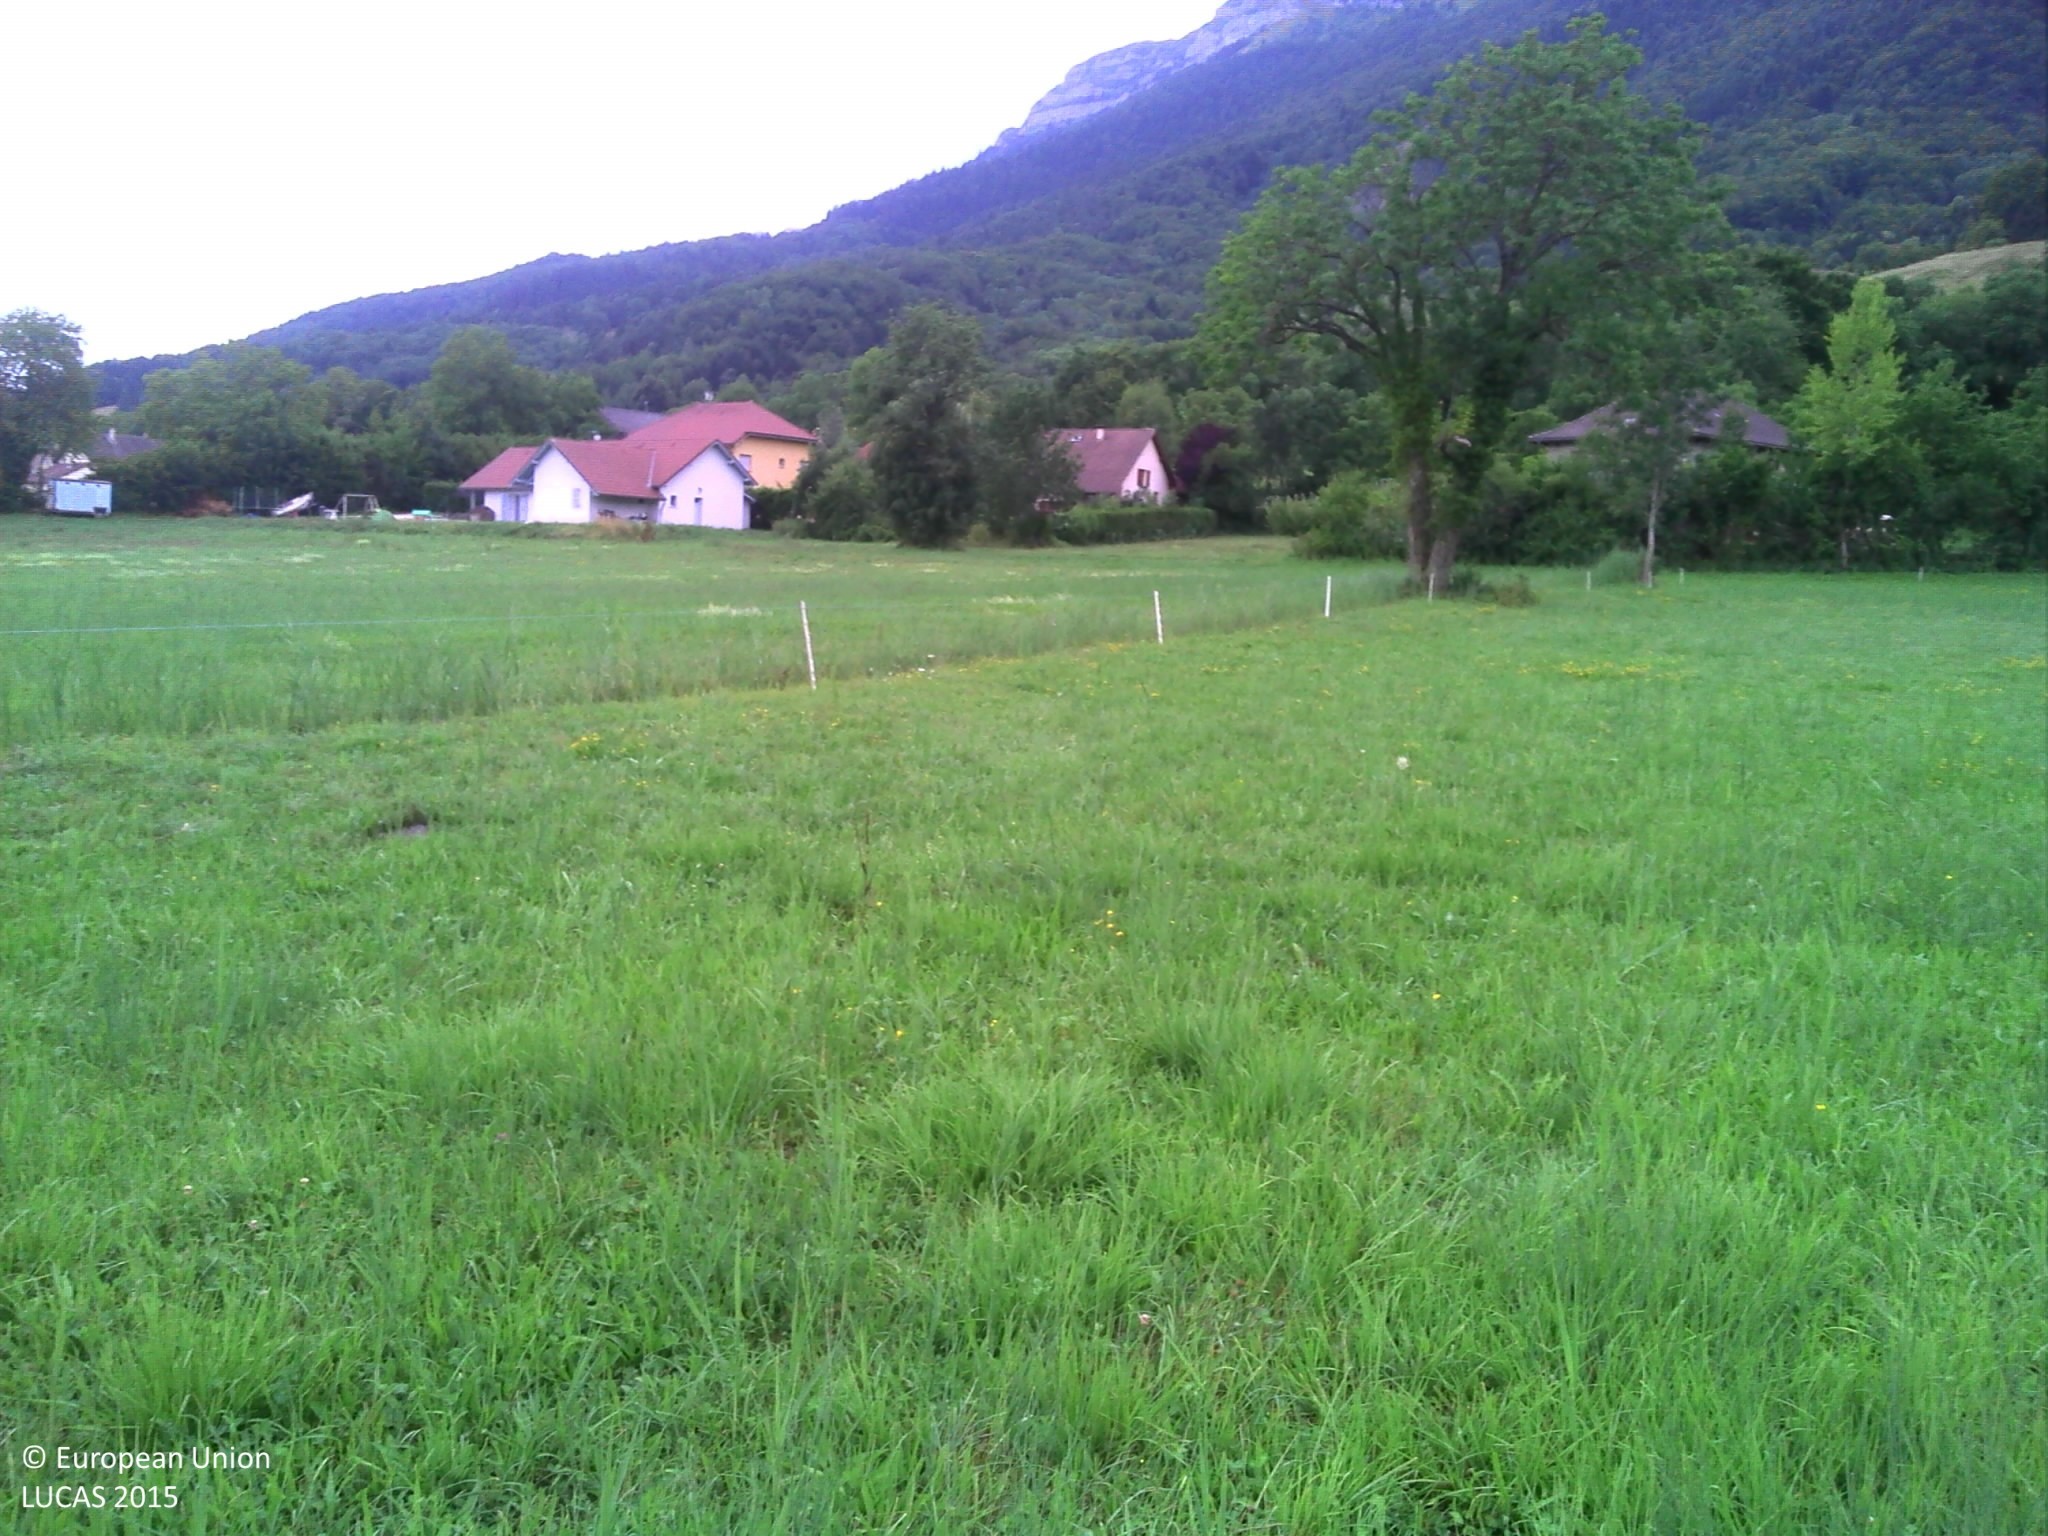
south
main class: Grassland
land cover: Grassland without tree/shrub cover
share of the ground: > 75 %
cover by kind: herbaceous plants 100 %
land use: Agriculture (excluding fallow land and kitchen gardens)
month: July
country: FR
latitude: 44.9438
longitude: 5.6082
